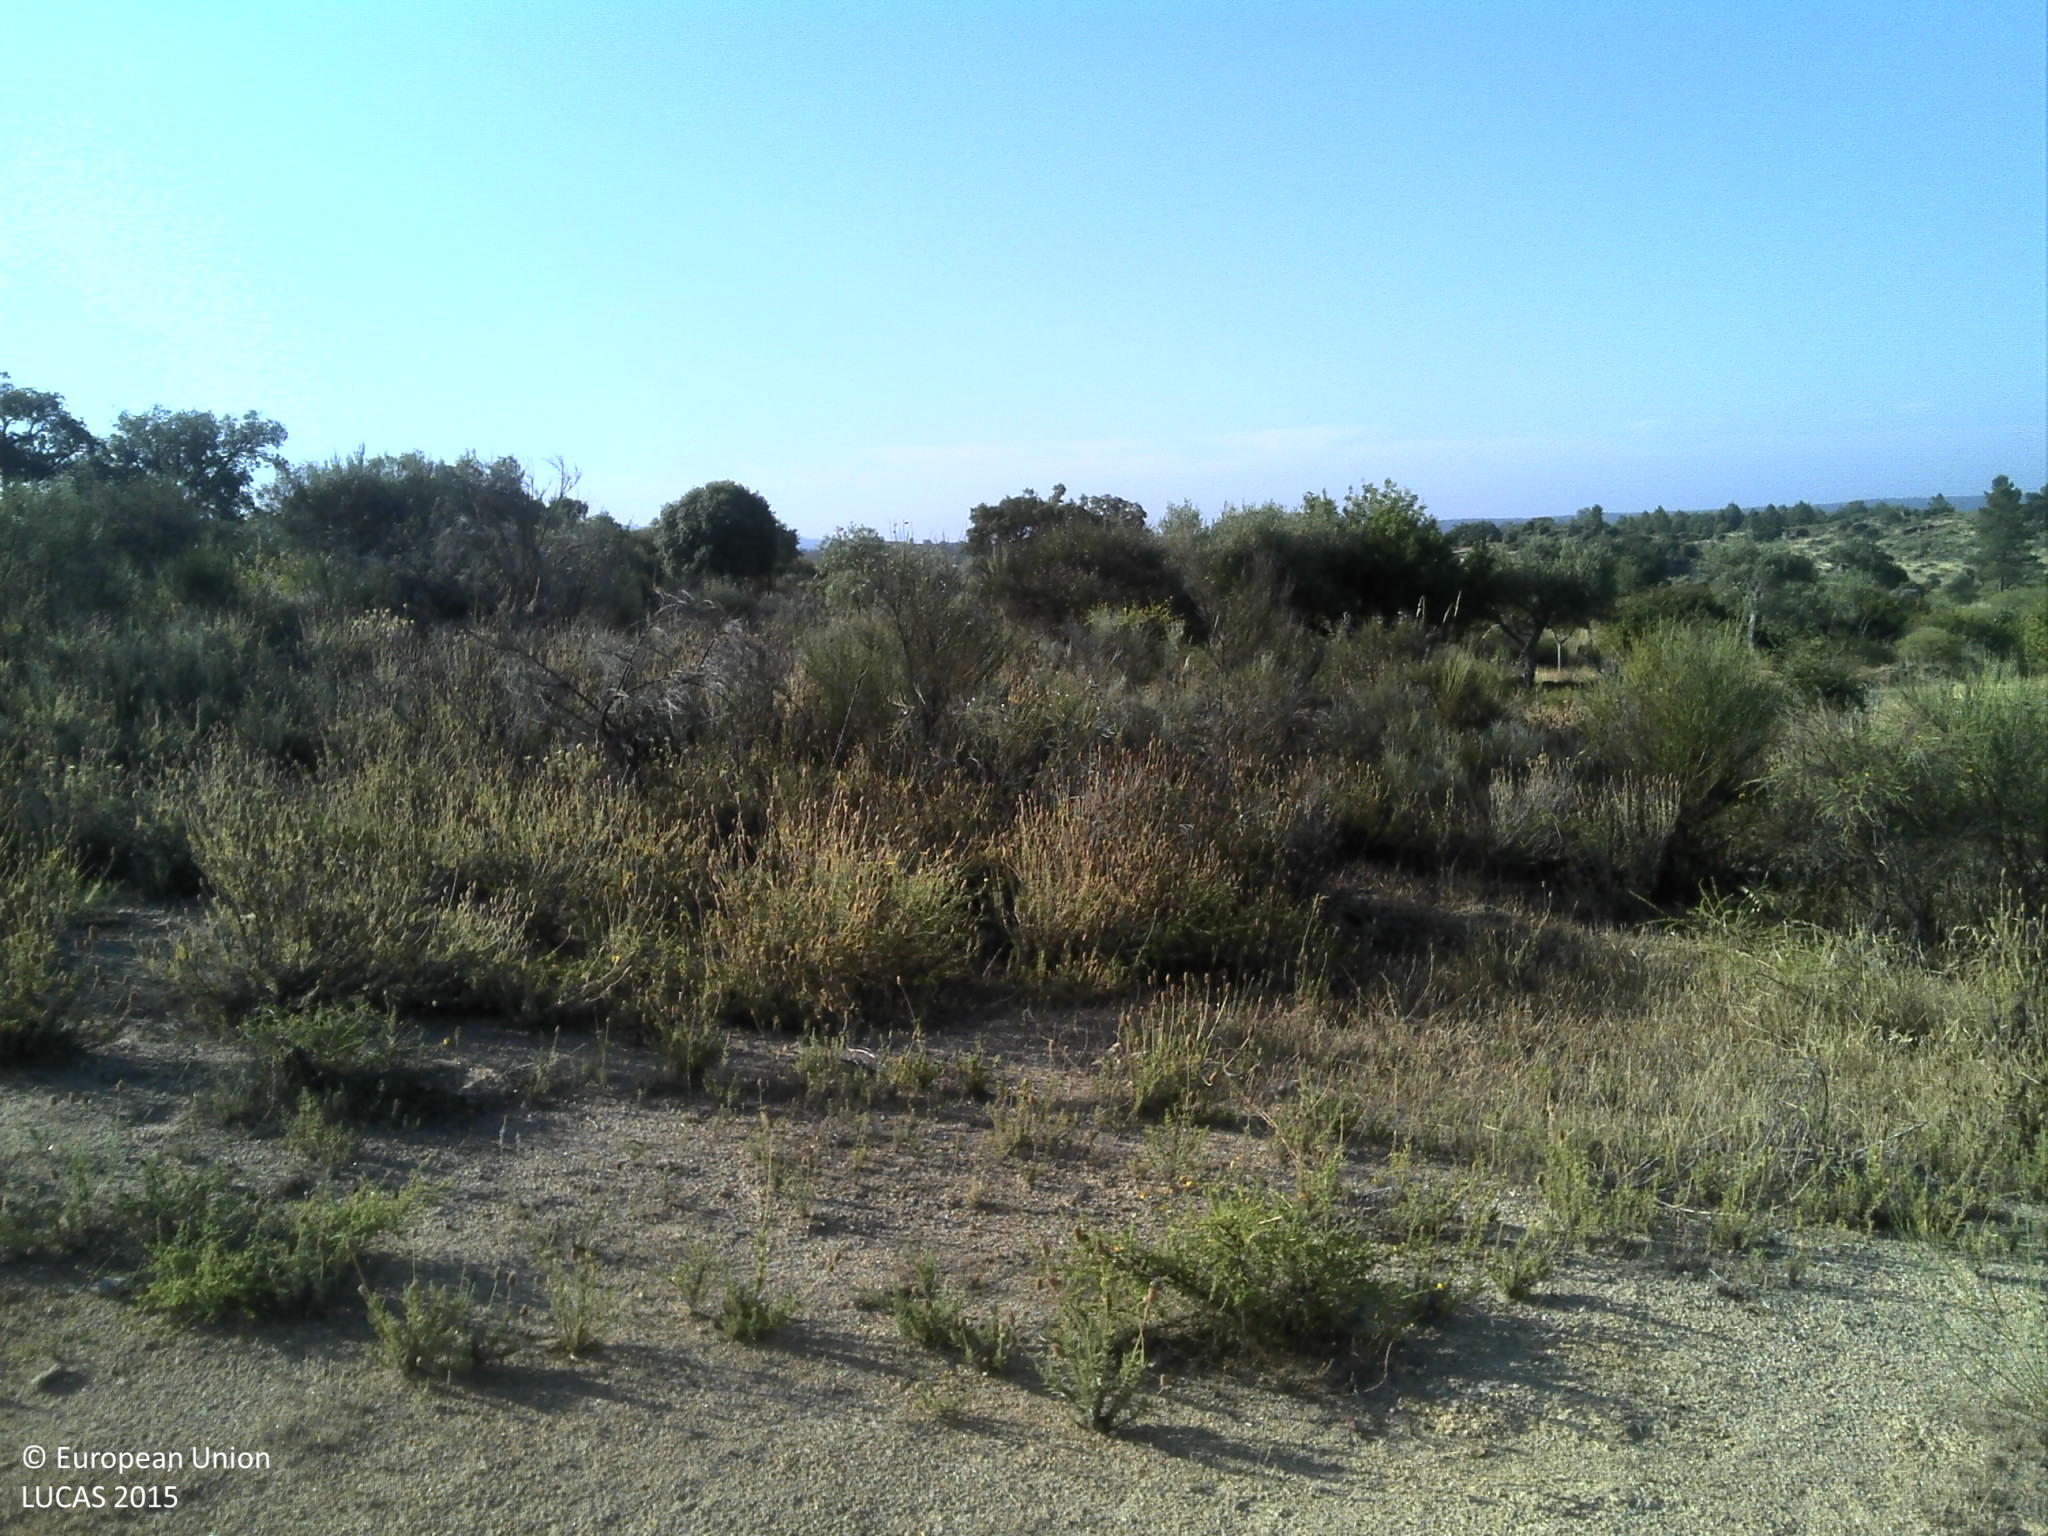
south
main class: Shrubland
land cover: Shrubland without tree cover
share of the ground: 50 - 75 %
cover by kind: shrubs 50 %, herbaceous plants 35 %, unconsolidated bare surface 10 %
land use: Forestry
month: June
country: PT
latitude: 40.0268
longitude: -7.0957
